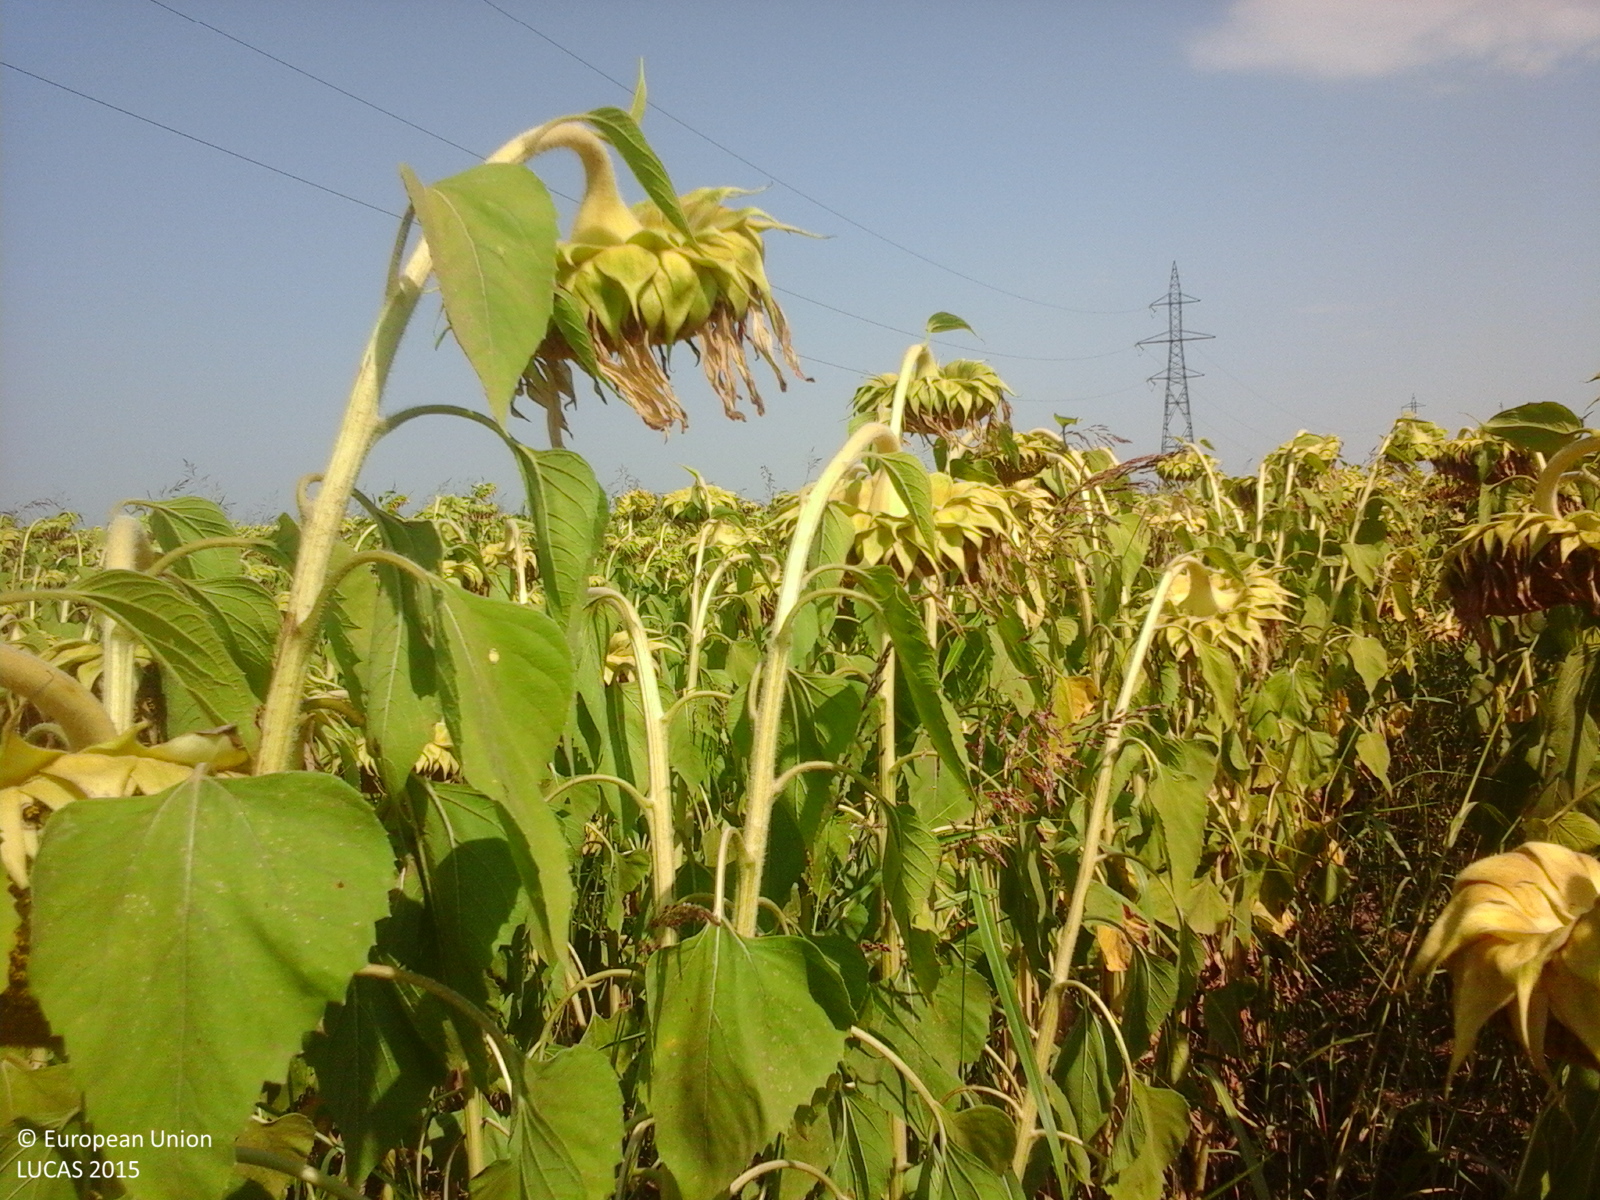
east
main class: Cropland
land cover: Sunflower
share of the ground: > 75 %
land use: Agriculture (excluding fallow land and kitchen gardens)
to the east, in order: Sunflower; Electric lines; Sunflower
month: August
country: RO
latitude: 45.2555
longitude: 27.7563
